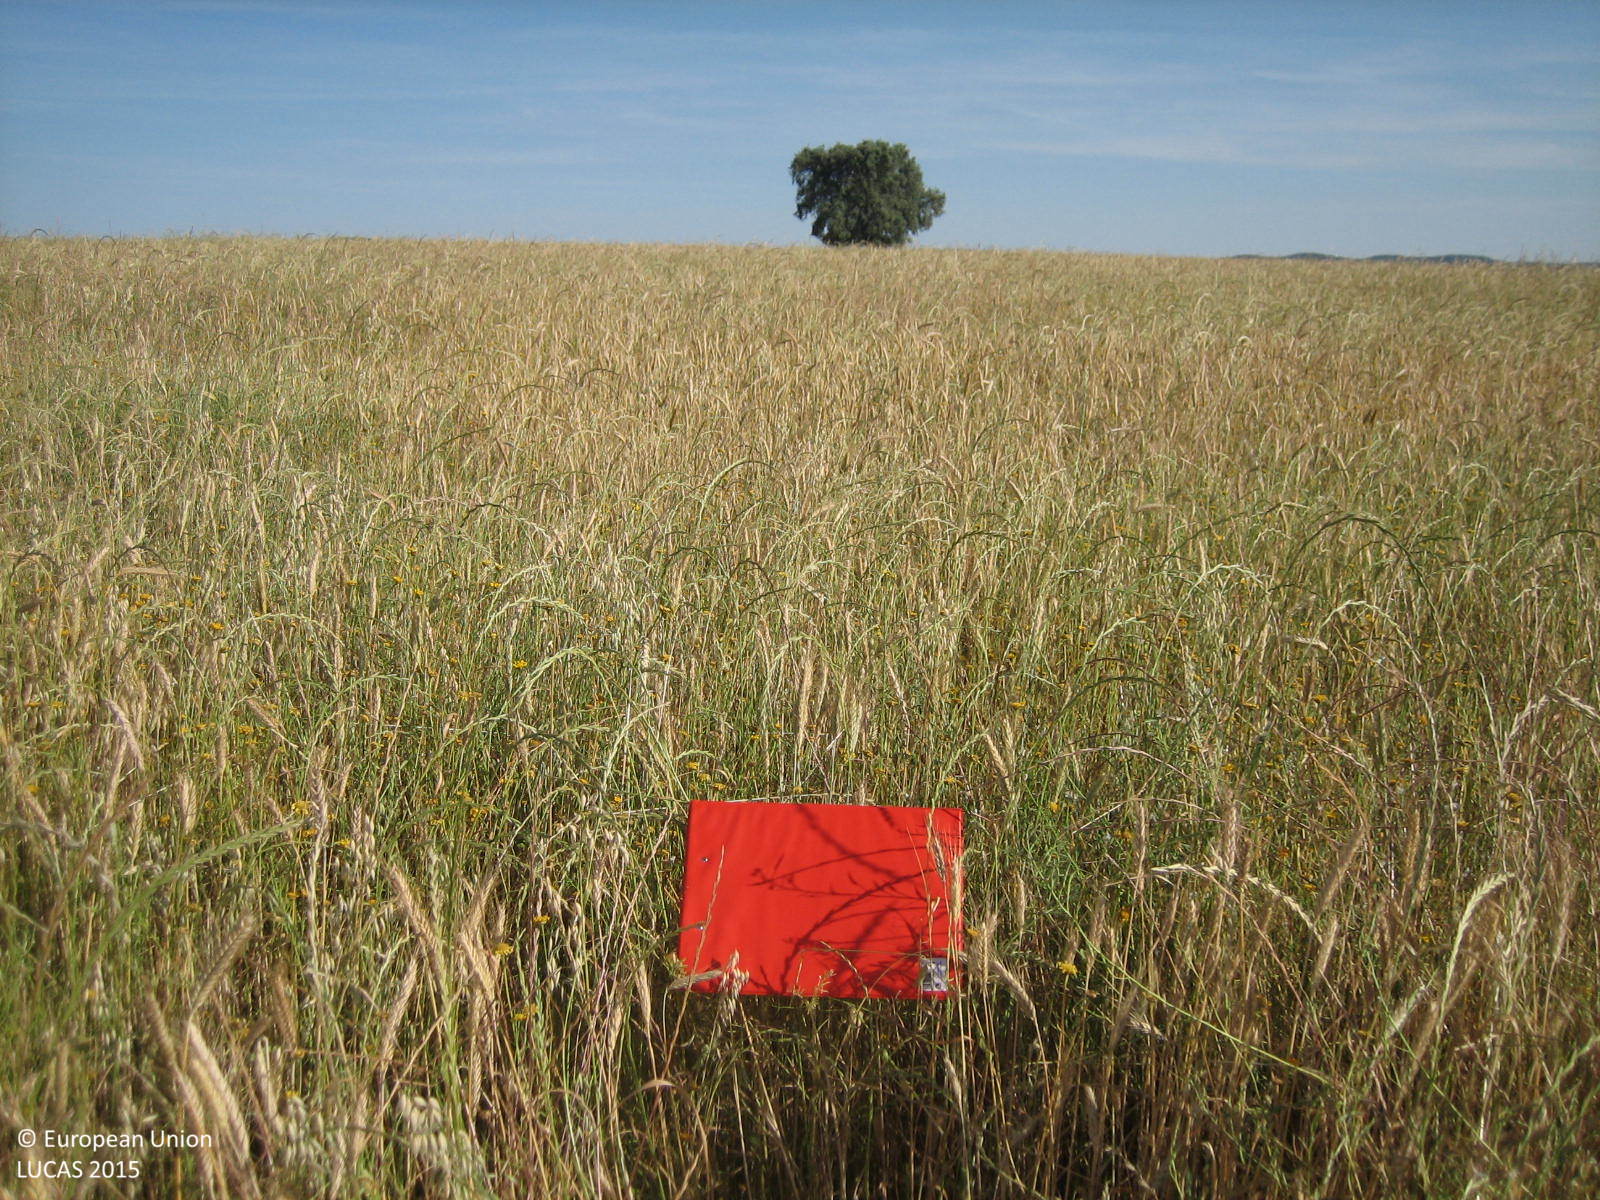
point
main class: Cropland
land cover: Mixed cereals for fodder
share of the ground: > 75 %
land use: Agriculture (excluding fallow land and kitchen gardens)
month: May
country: ES
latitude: 39.0444
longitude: -4.8109
